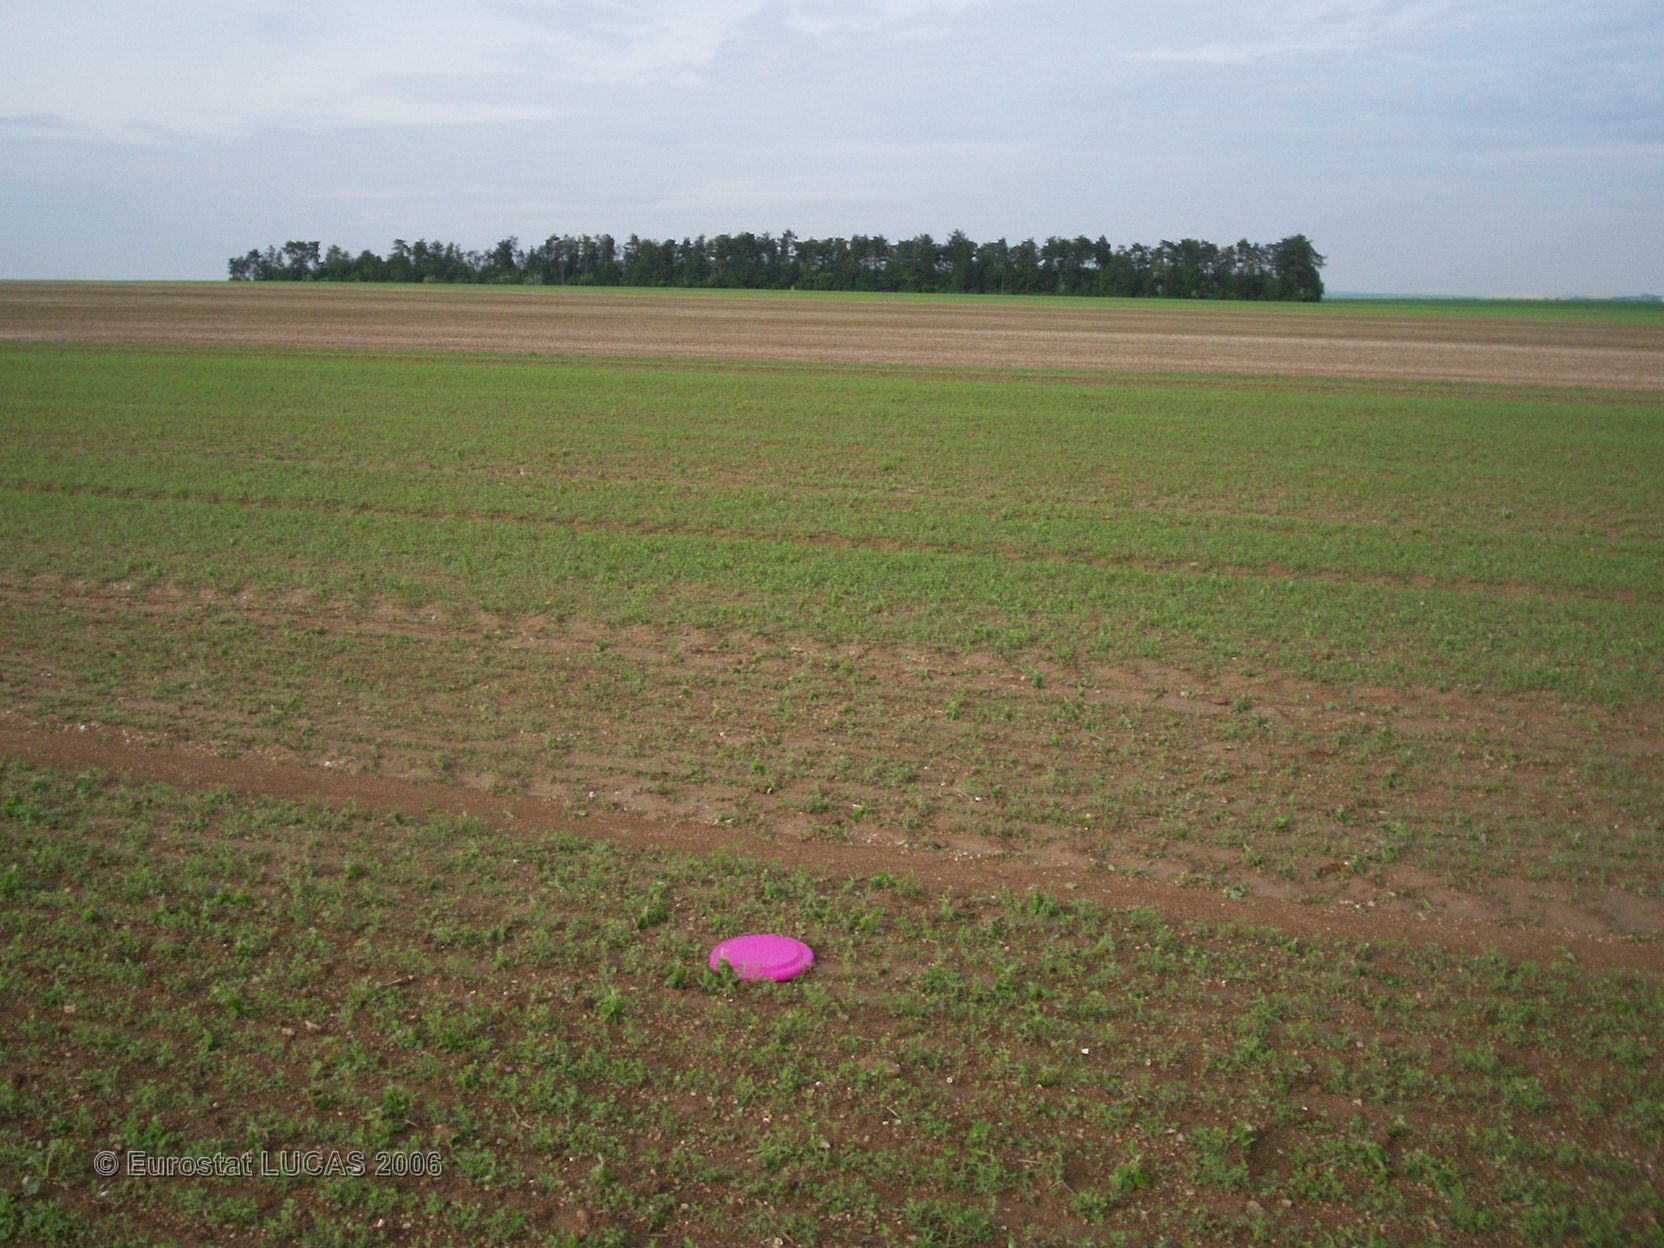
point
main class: Cropland
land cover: Lucerne
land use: Agriculture (excluding fallow land and kitchen gardens)
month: May
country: FR
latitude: 49.1792
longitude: 4.3579
